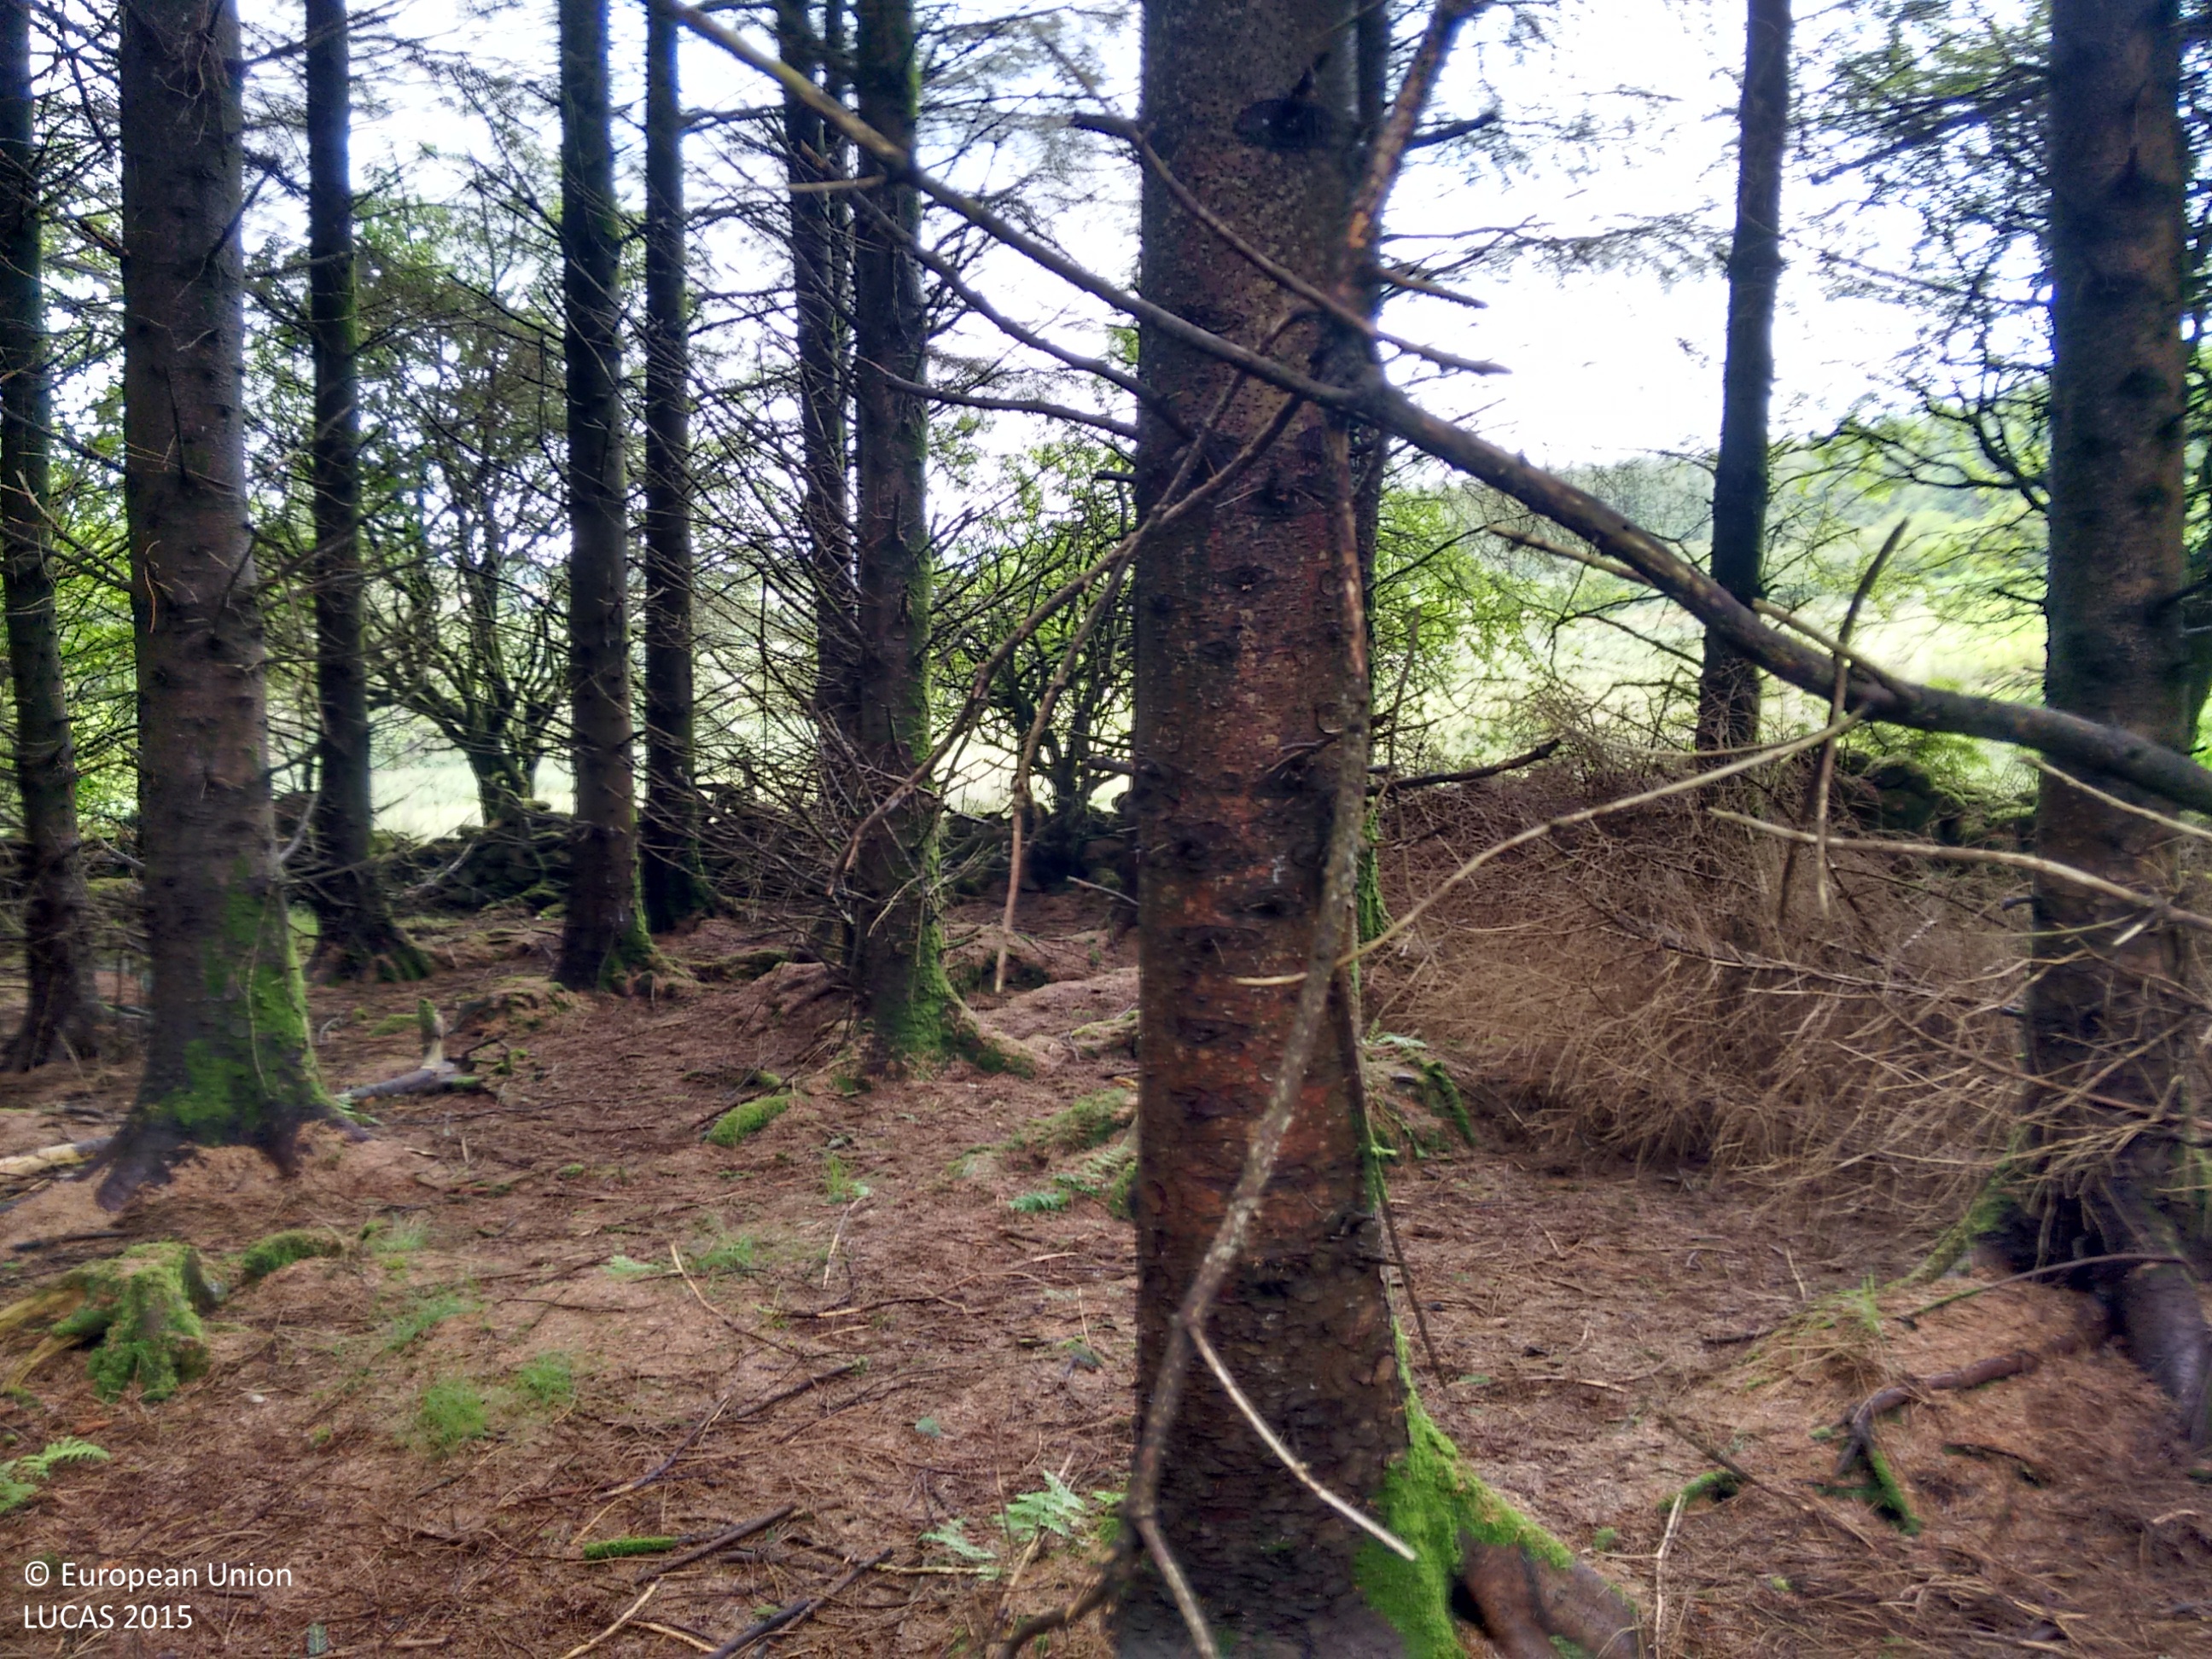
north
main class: Woodland
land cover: Spruce dominated coniferous woodland
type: exotic forest
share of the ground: > 75 %
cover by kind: coniferous forest trees 100 %
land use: Forestry
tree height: > 5 m
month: July
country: IE
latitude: 52.8714
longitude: -6.4533
